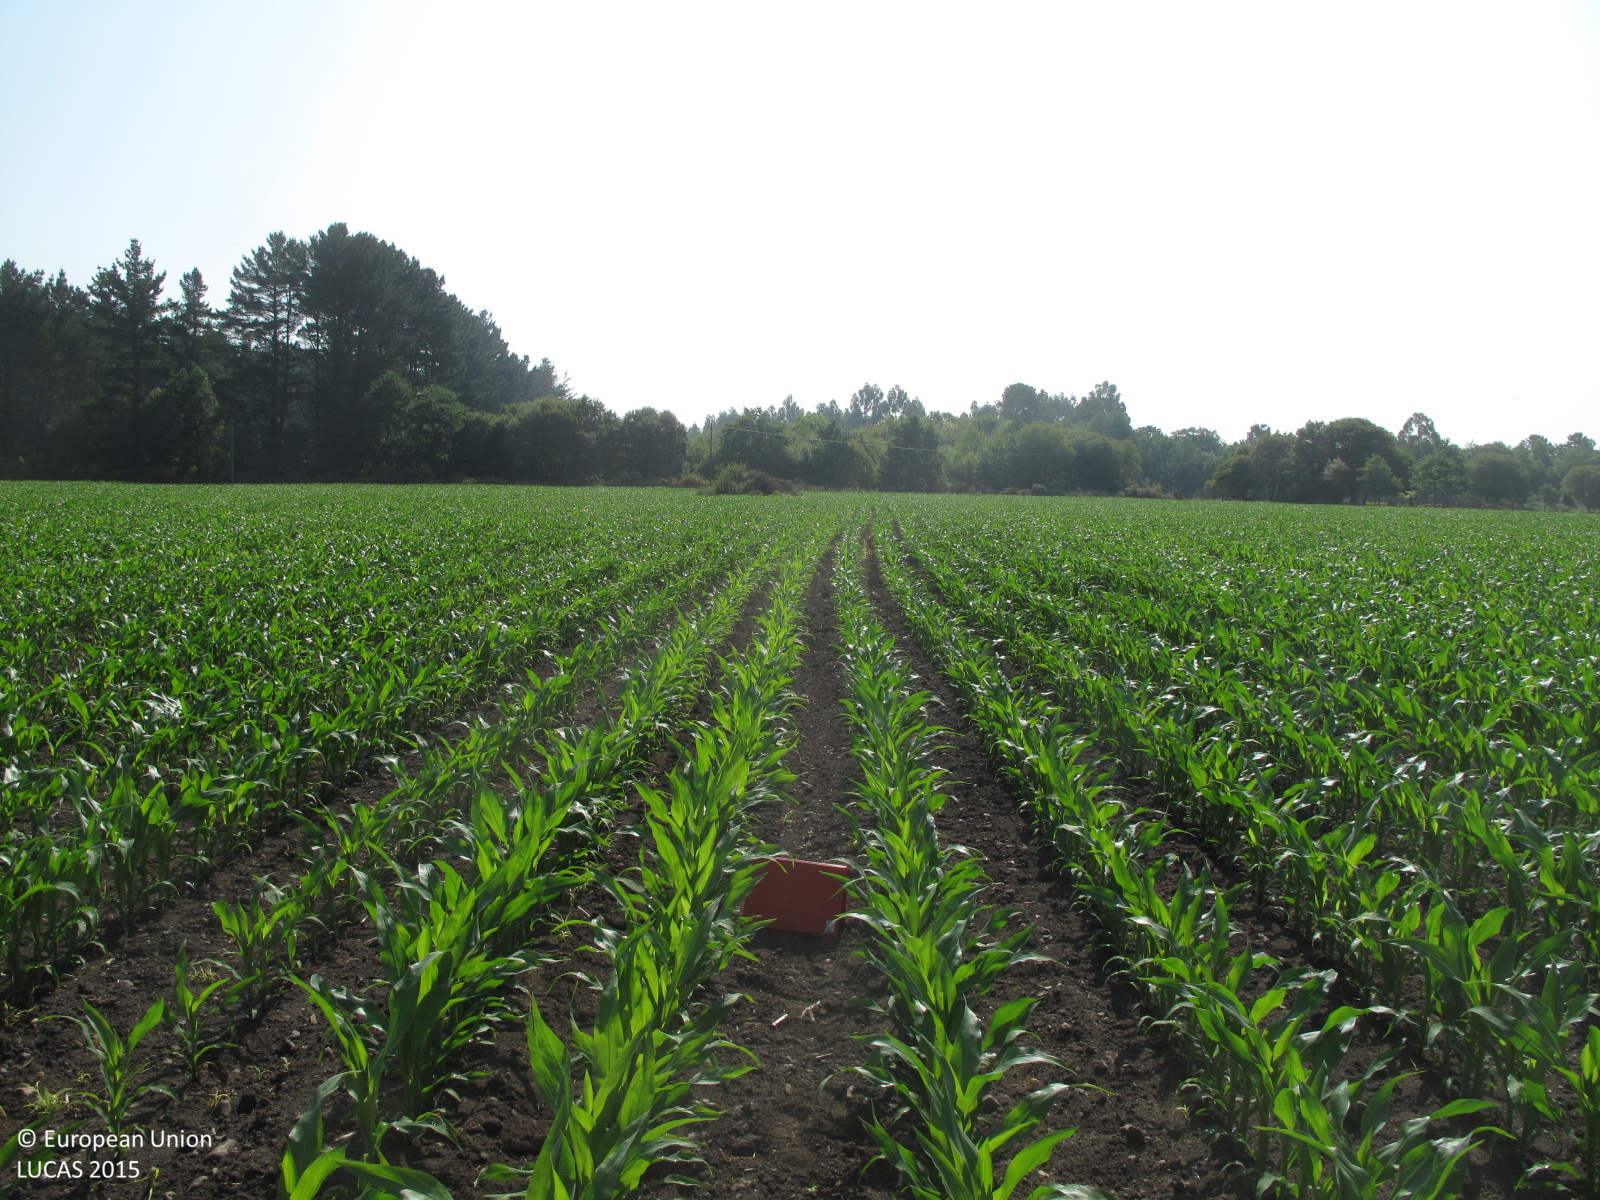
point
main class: Cropland
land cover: Maize
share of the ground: 25 - 50 %
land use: Agriculture (excluding fallow land and kitchen gardens)
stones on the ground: < 10 %
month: June
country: ES
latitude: 43.1680
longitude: -7.8872
